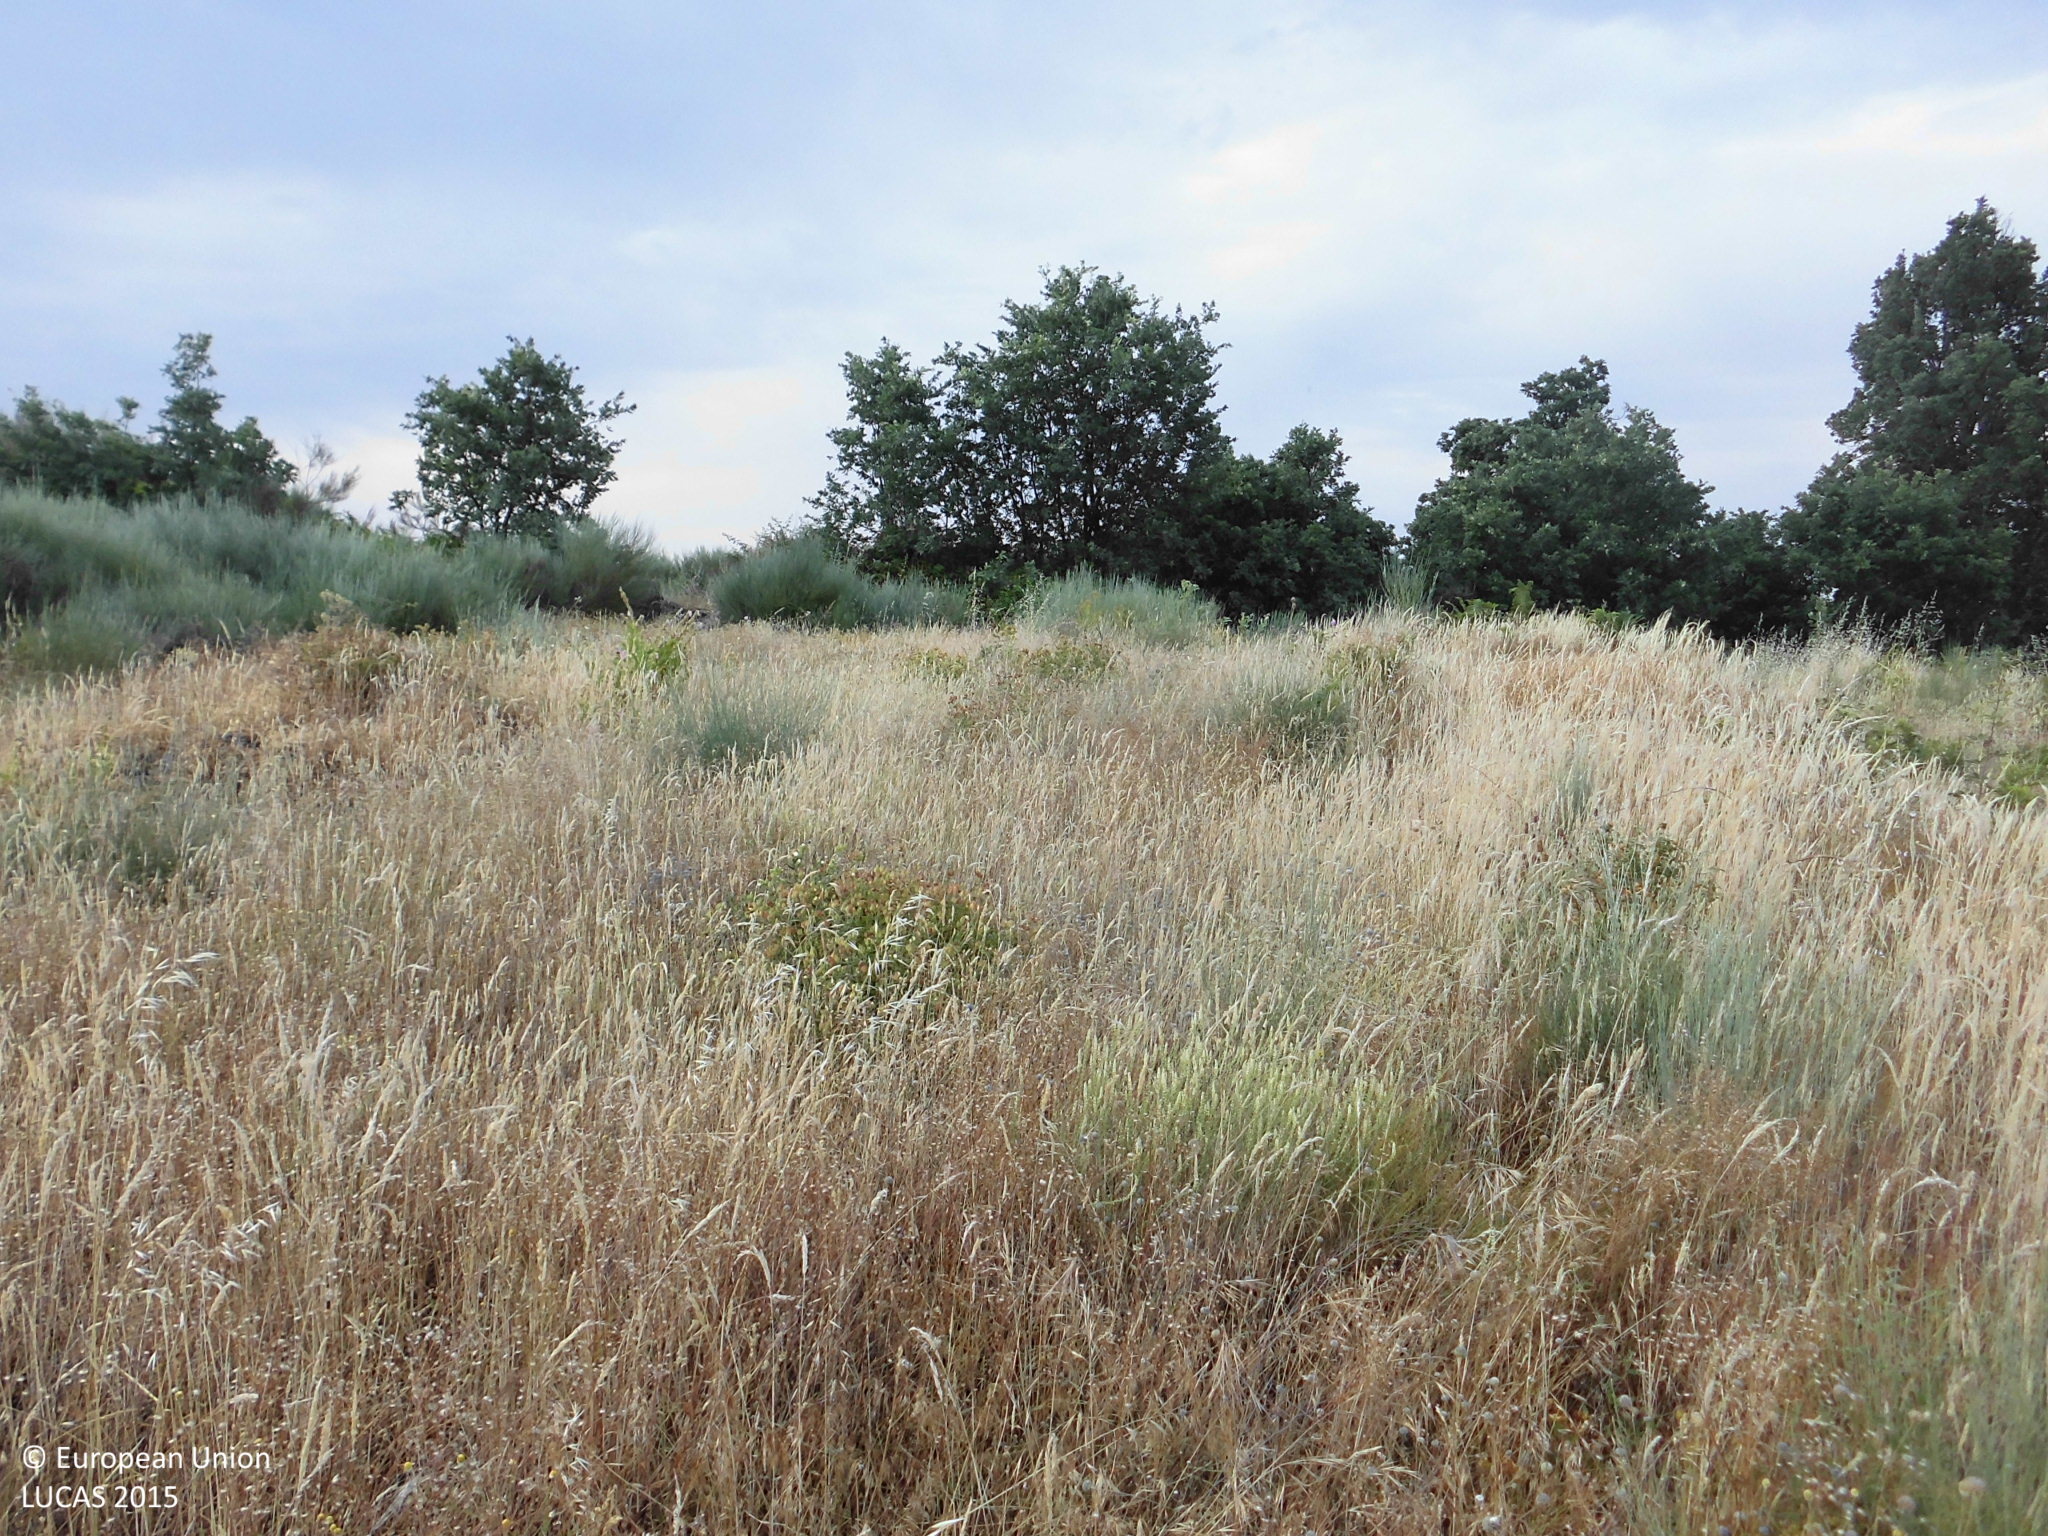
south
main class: Cropland
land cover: Olive groves
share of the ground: < 10 %
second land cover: Spontaneously vegetated surfaces
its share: > 75 %
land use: Agriculture (excluding fallow land and kitchen gardens)
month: June
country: ES
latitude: 40.0976
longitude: -5.7011
